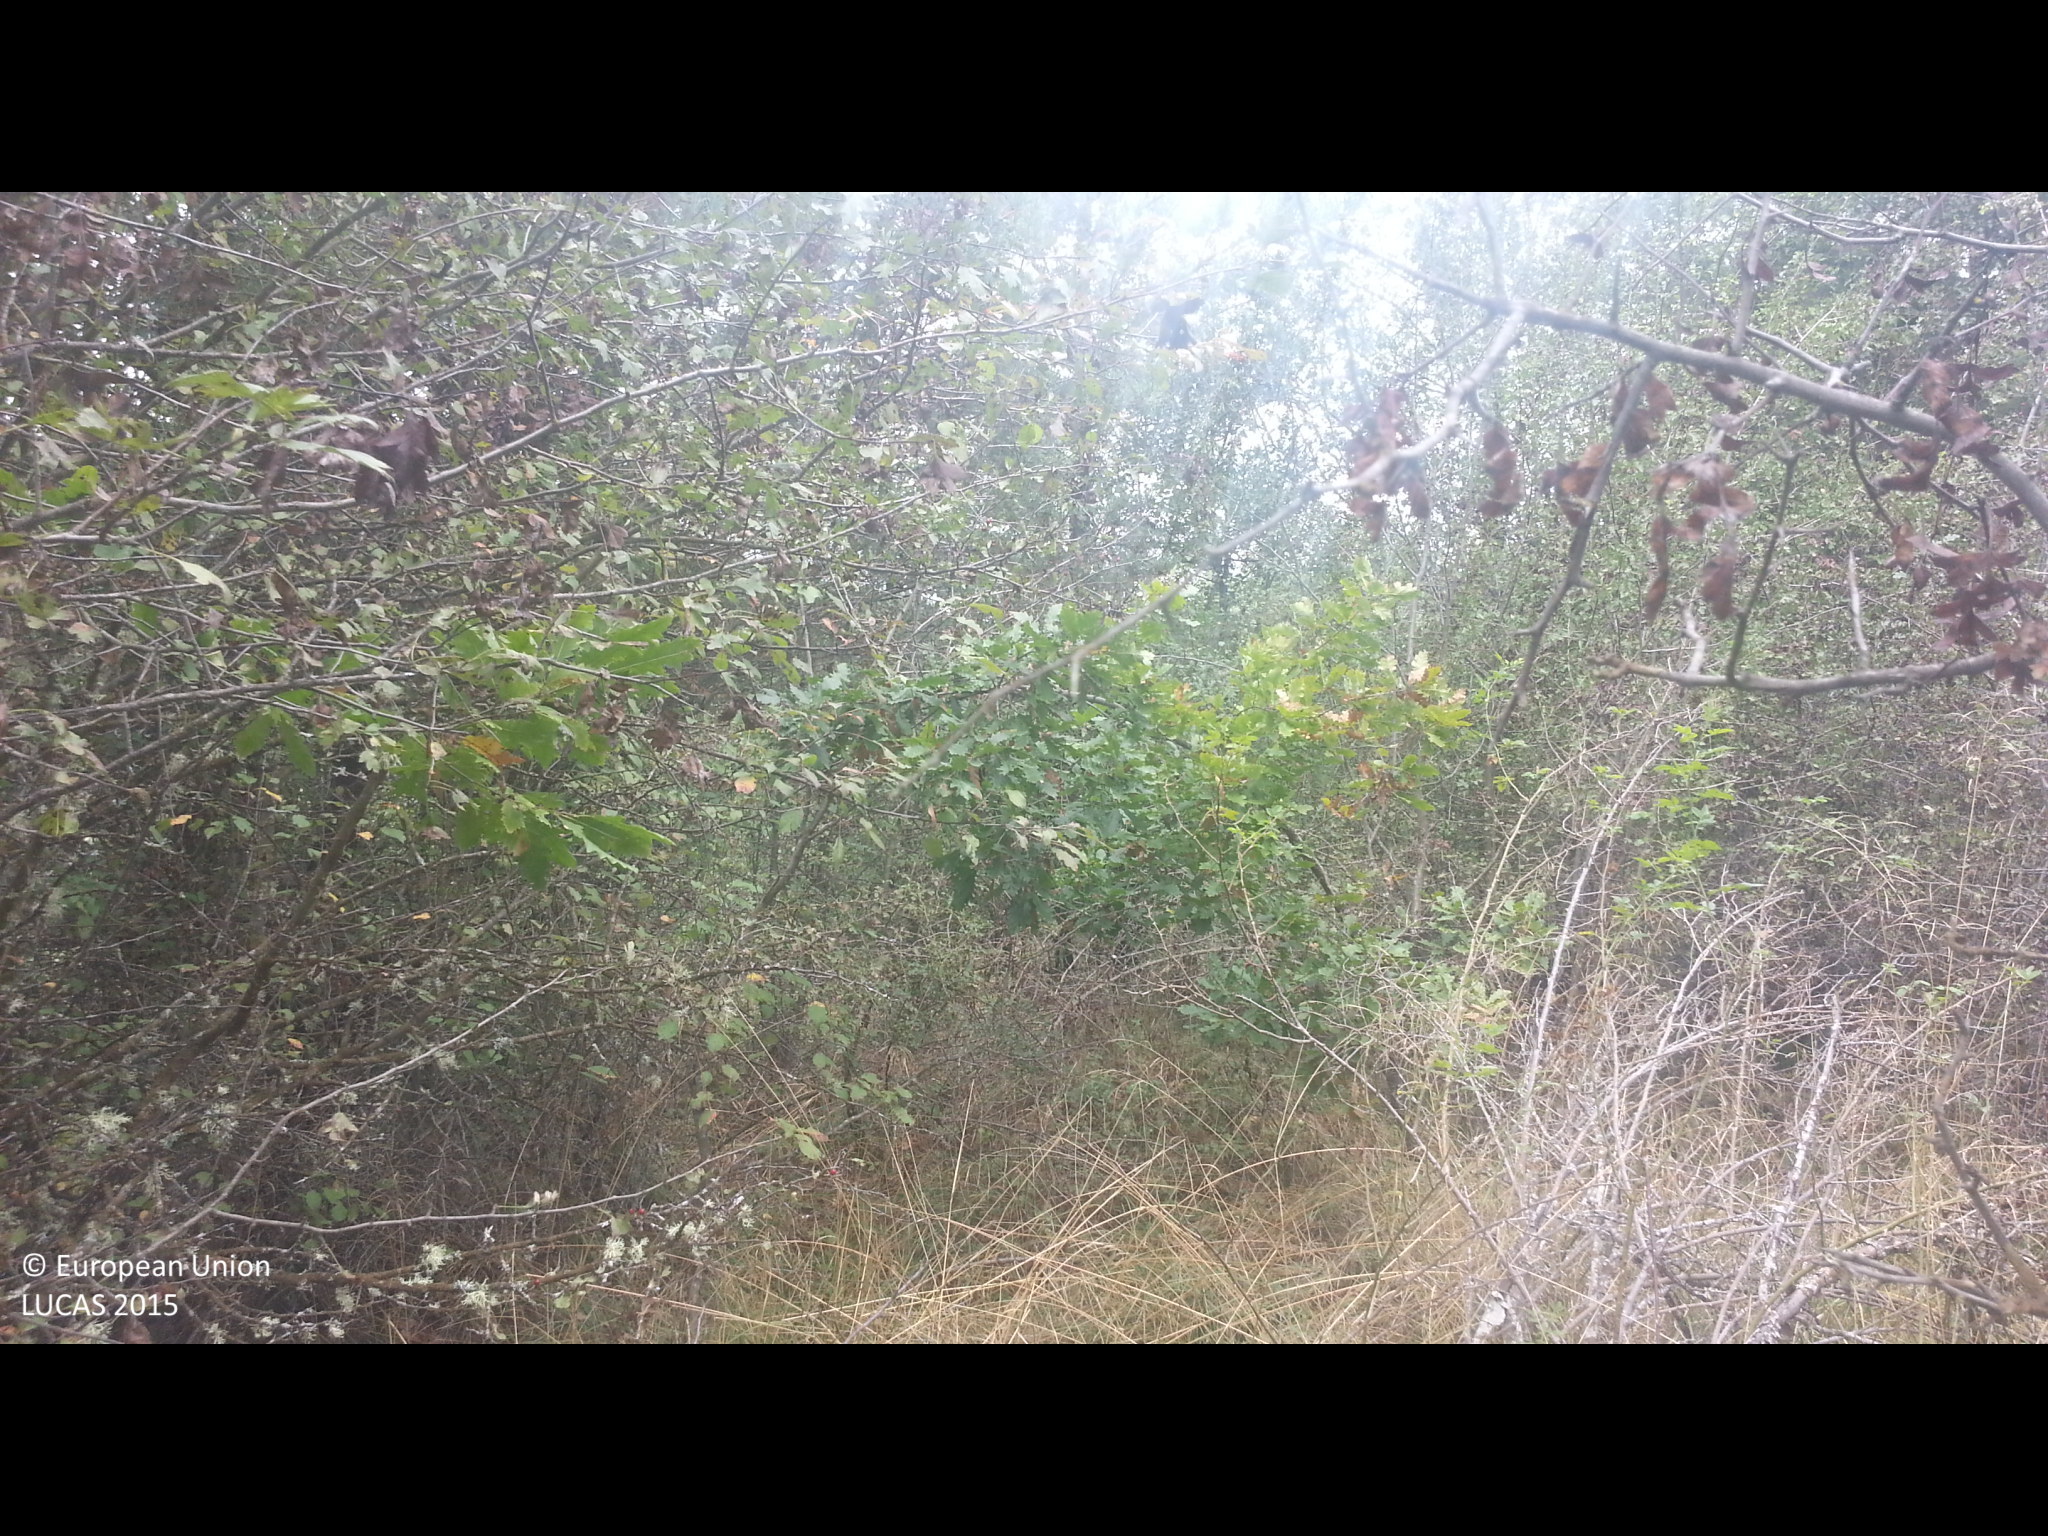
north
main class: Woodland
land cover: Other mixed woodland
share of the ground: > 75 %
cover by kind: broadleaved forest trees 70 %, coniferous forest trees 25 %, shrubs 5 %
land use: Forestry
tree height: < 5 m
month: September
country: BG
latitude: 42.5243
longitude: 22.5732
